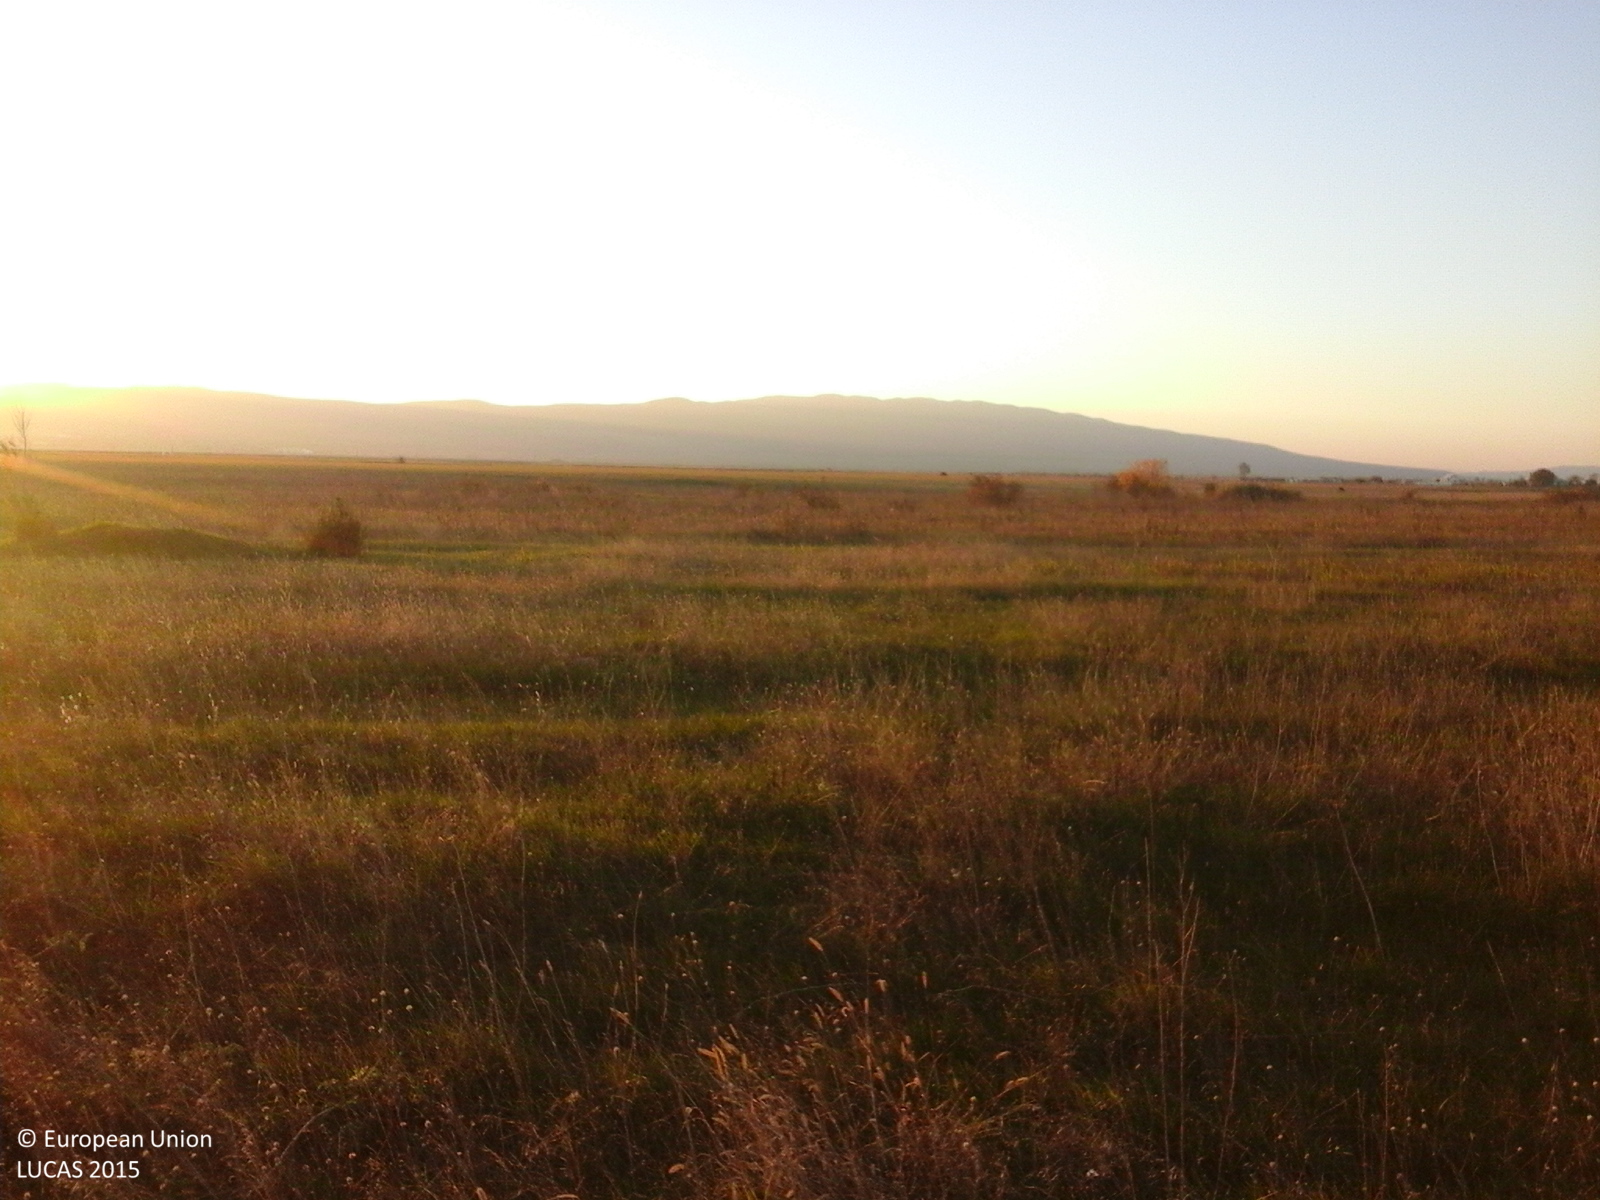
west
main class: Grassland
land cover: Grassland without tree/shrub cover
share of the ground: > 75 %
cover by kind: herbaceous plants 100 %
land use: Agriculture (excluding fallow land and kitchen gardens)
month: October
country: RO
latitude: 45.8003
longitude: 27.1422
